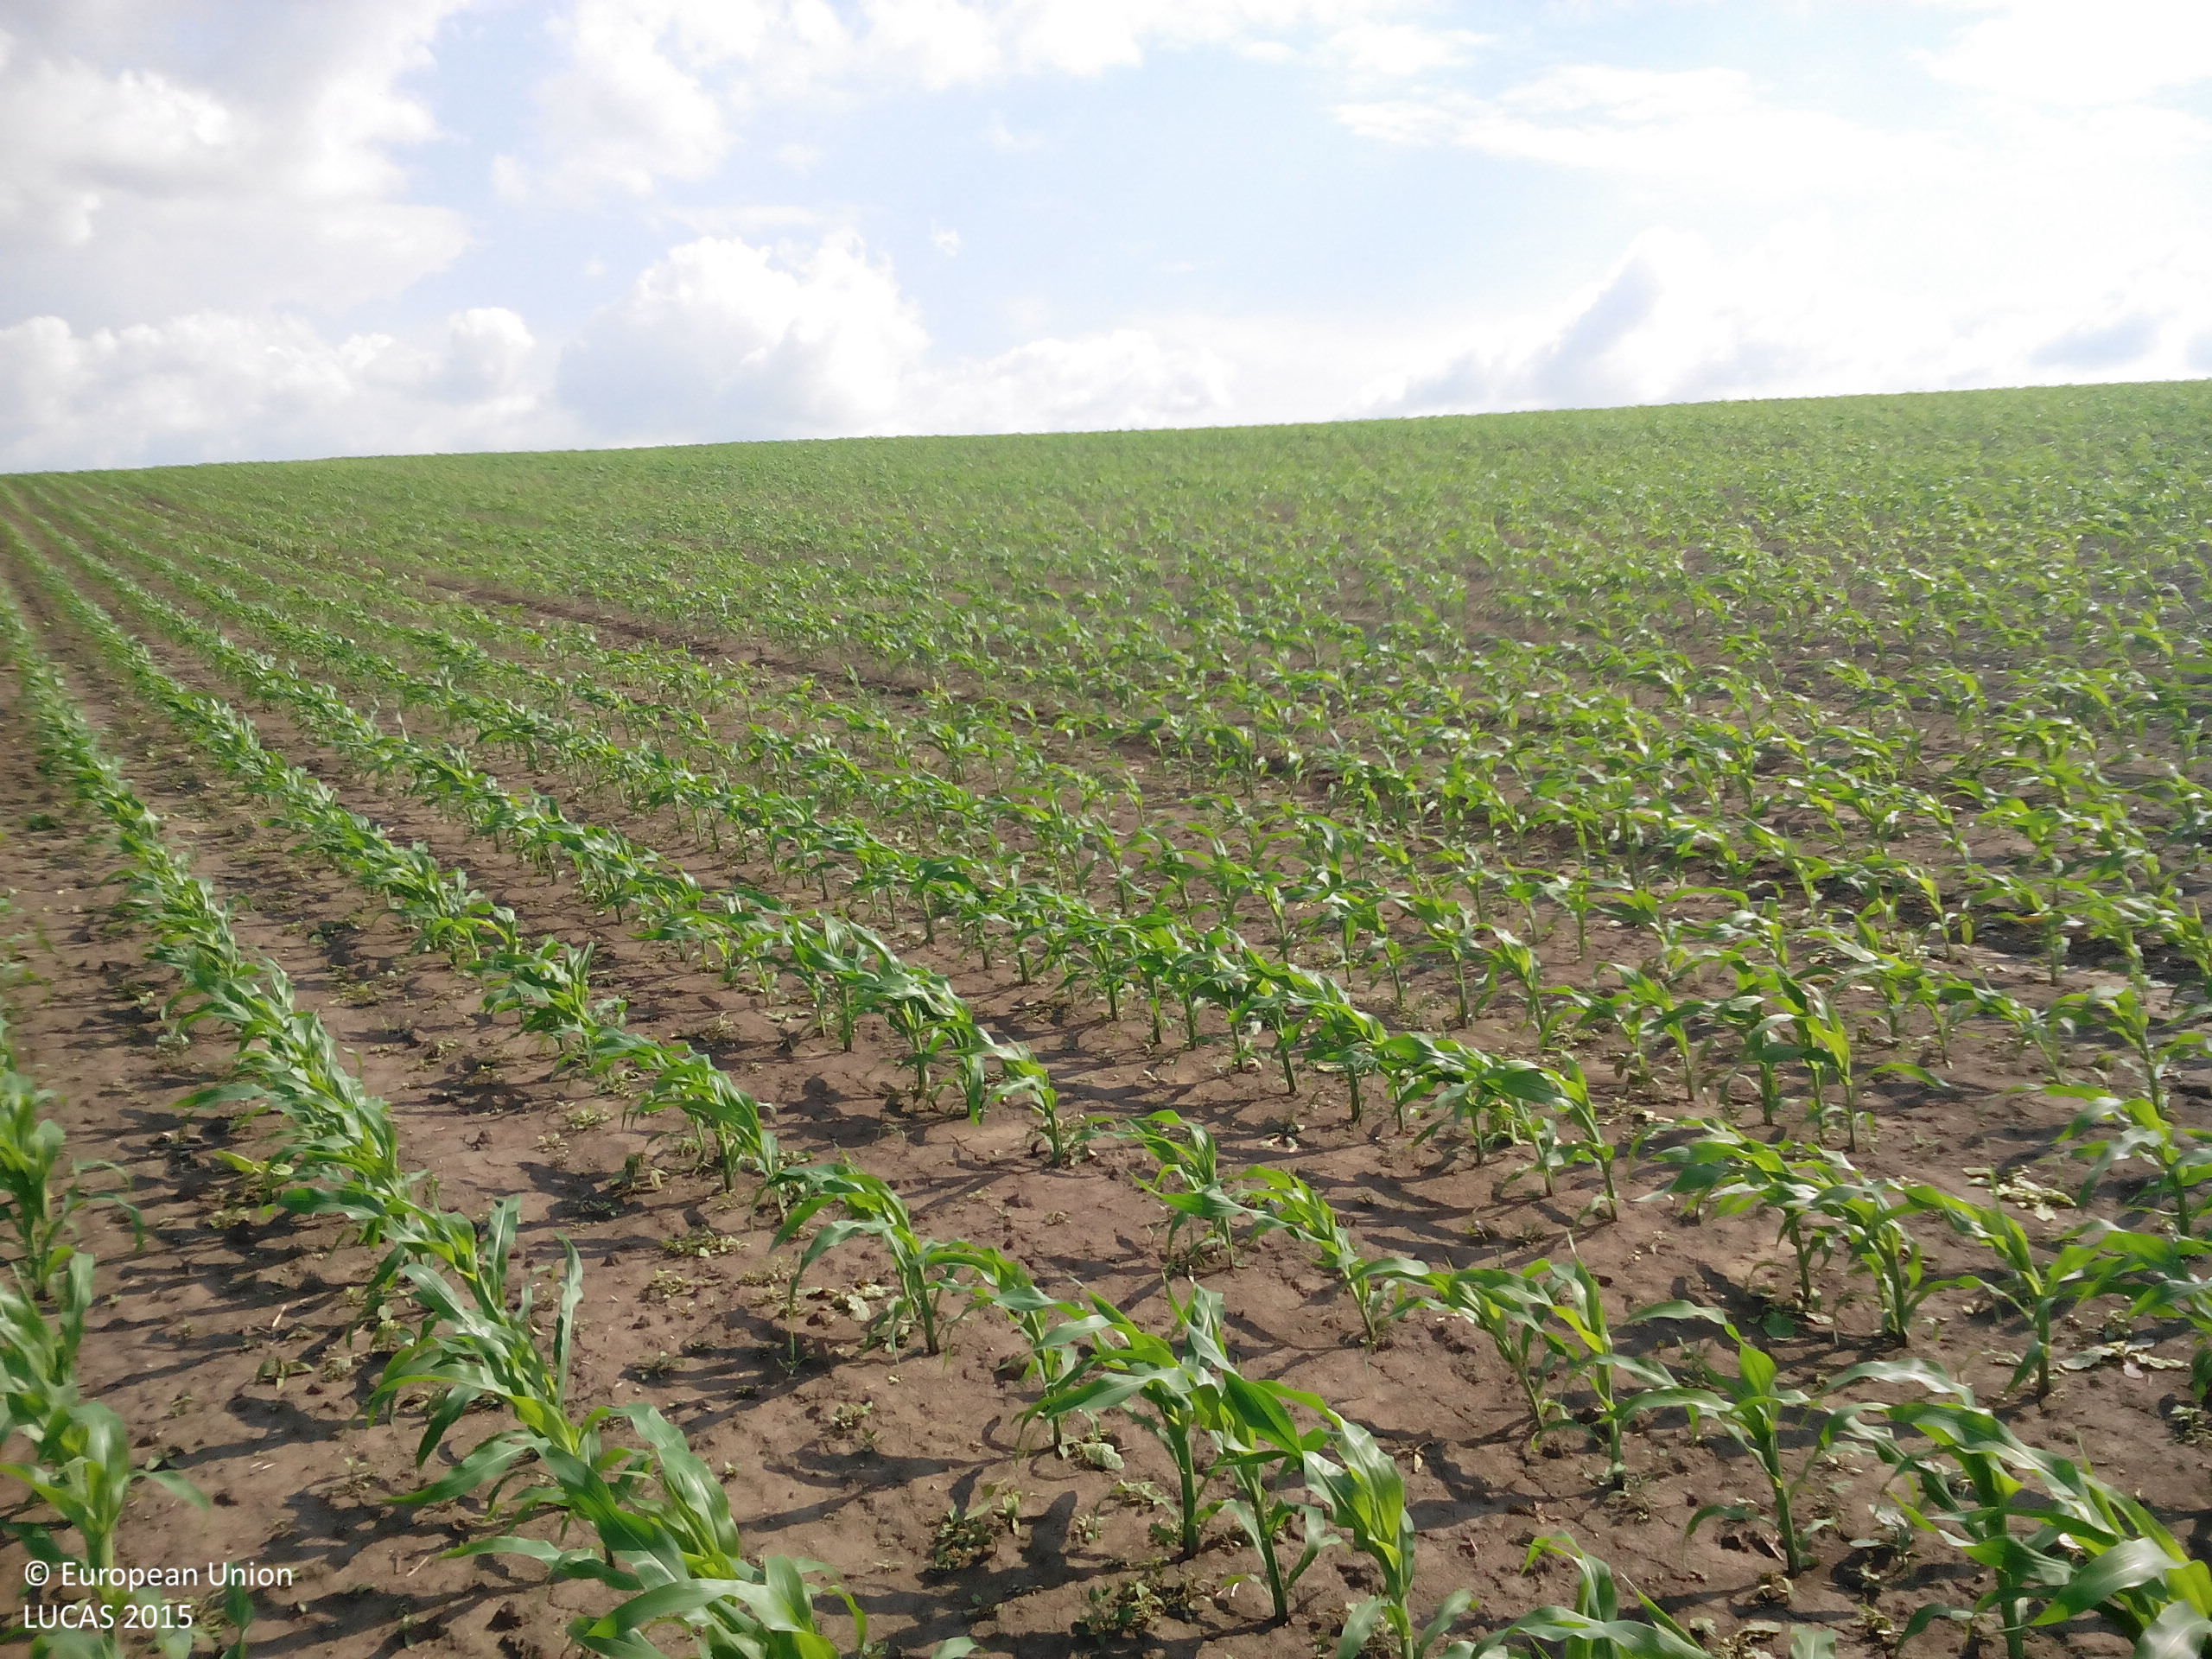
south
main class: Cropland
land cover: Maize
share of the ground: 25 - 50 %
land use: Agriculture (excluding fallow land and kitchen gardens)
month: May
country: BG
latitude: 43.5927
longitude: 24.1647
